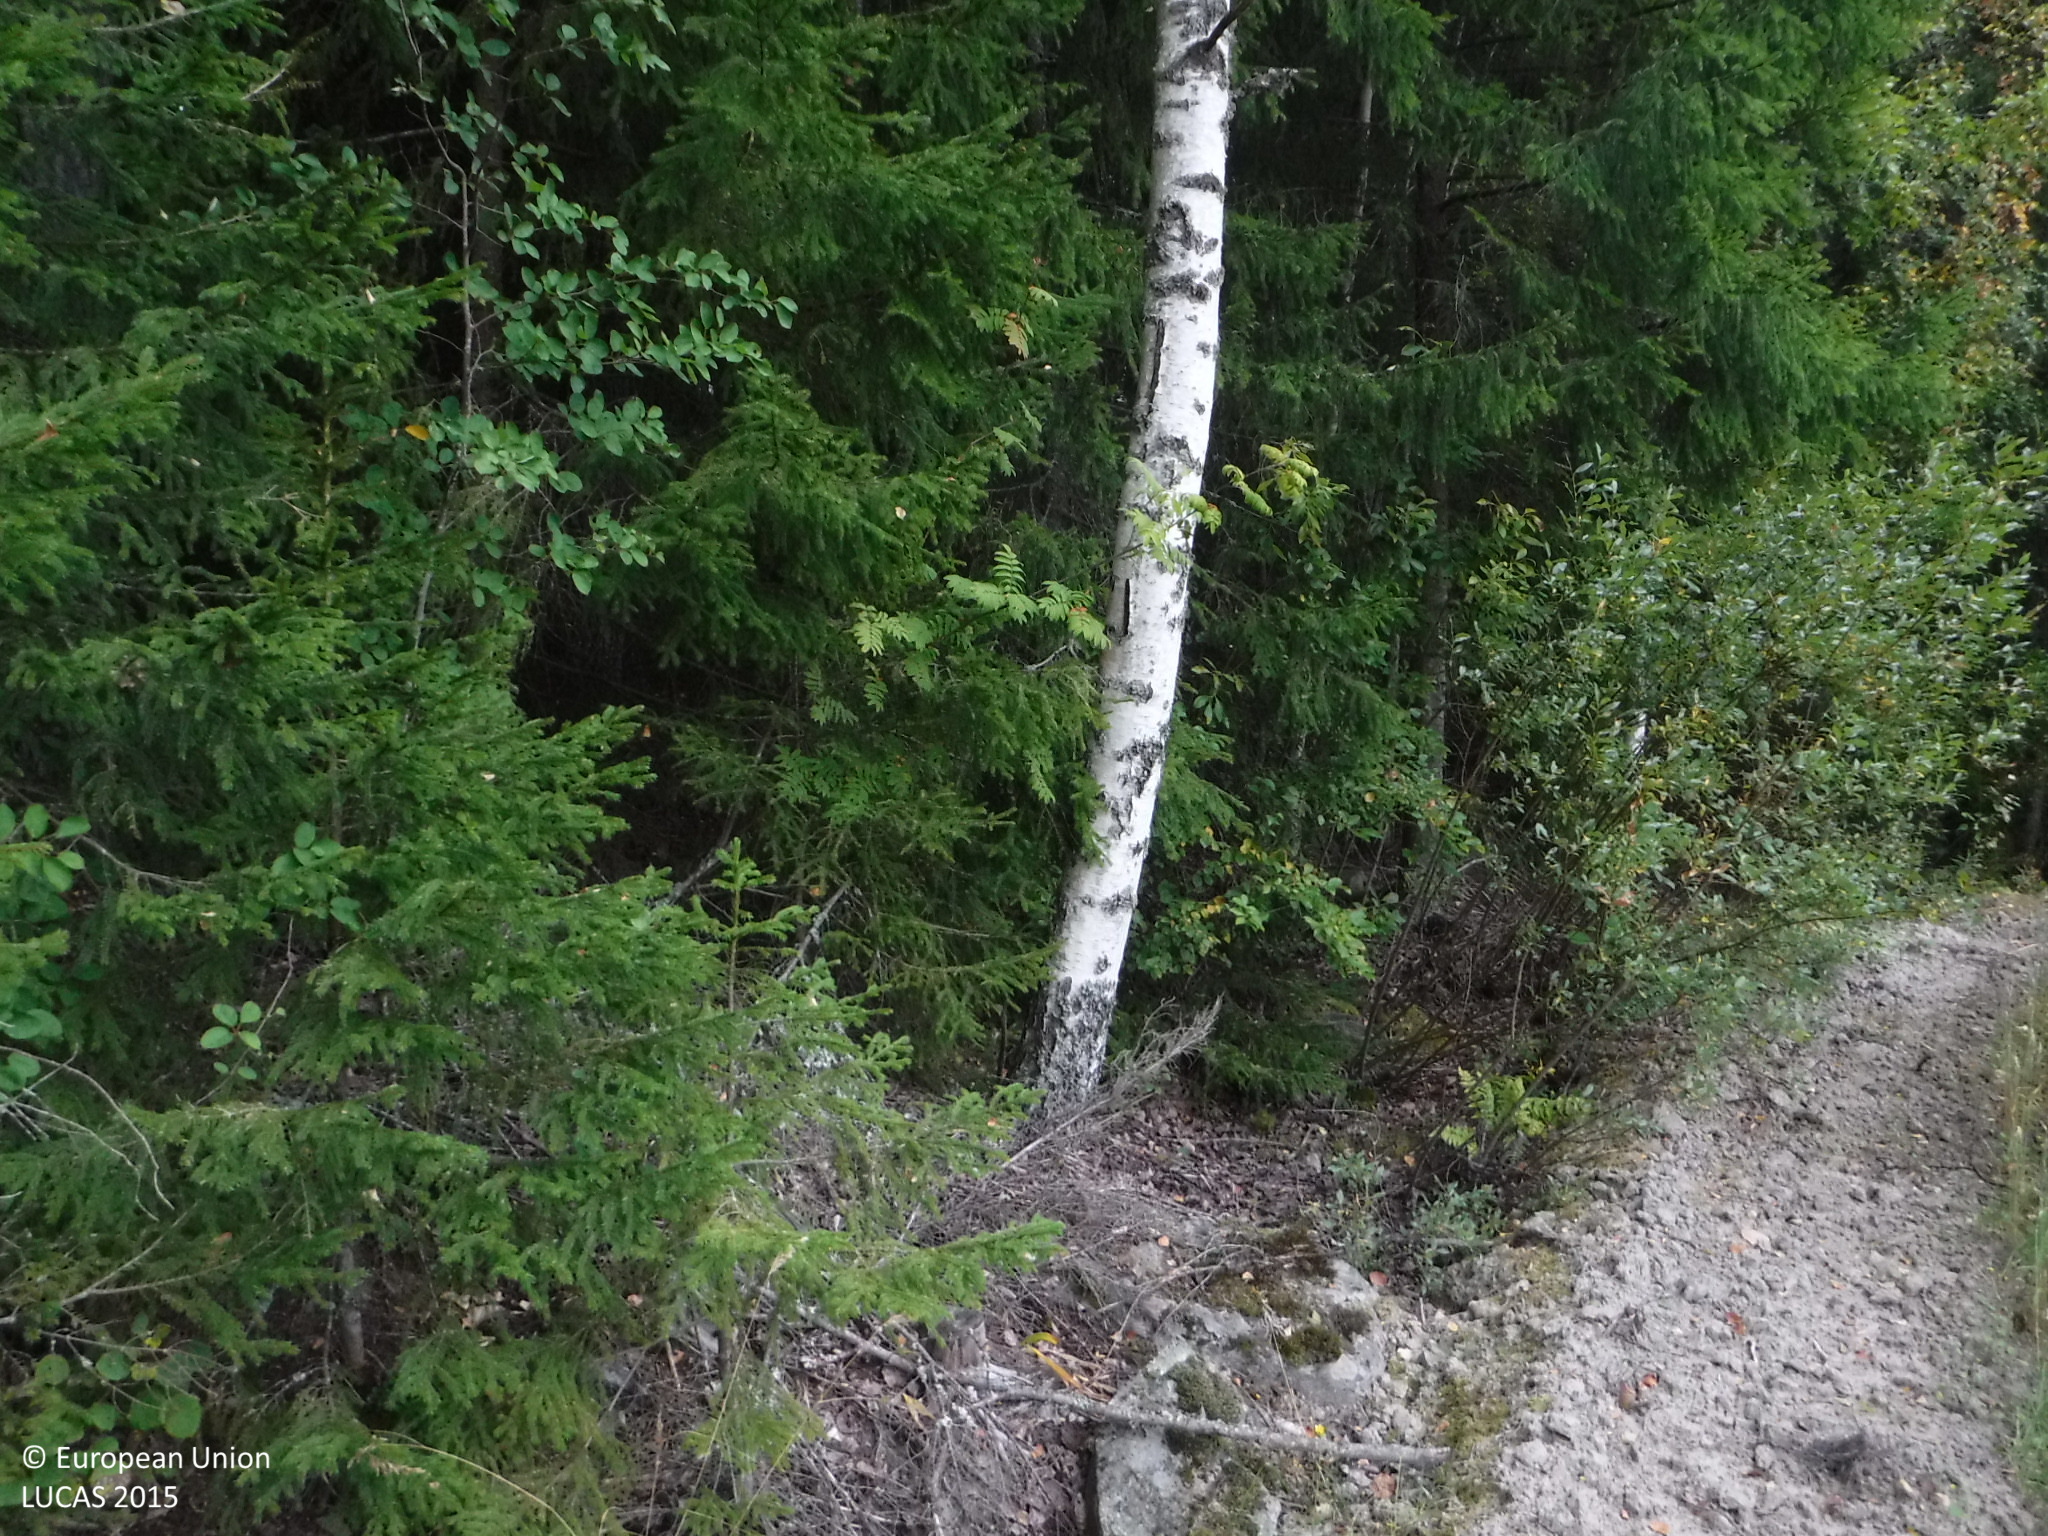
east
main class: Cropland
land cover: Common wheat
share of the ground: > 75 %
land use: Agriculture (excluding fallow land and kitchen gardens)
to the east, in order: Common wheat; Ditches and canals; Spruce dominated mixed woodland; Spruce dominated coniferous woodland; Grassland without tree/shrub cover; Paved roads, cycling and walking lanes; Grass margins; Ditches and canals; Electric lines; Other coniferous woodland; Artificial constructions in urban areas
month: August
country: FI
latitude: 61.2415
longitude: 22.9850
